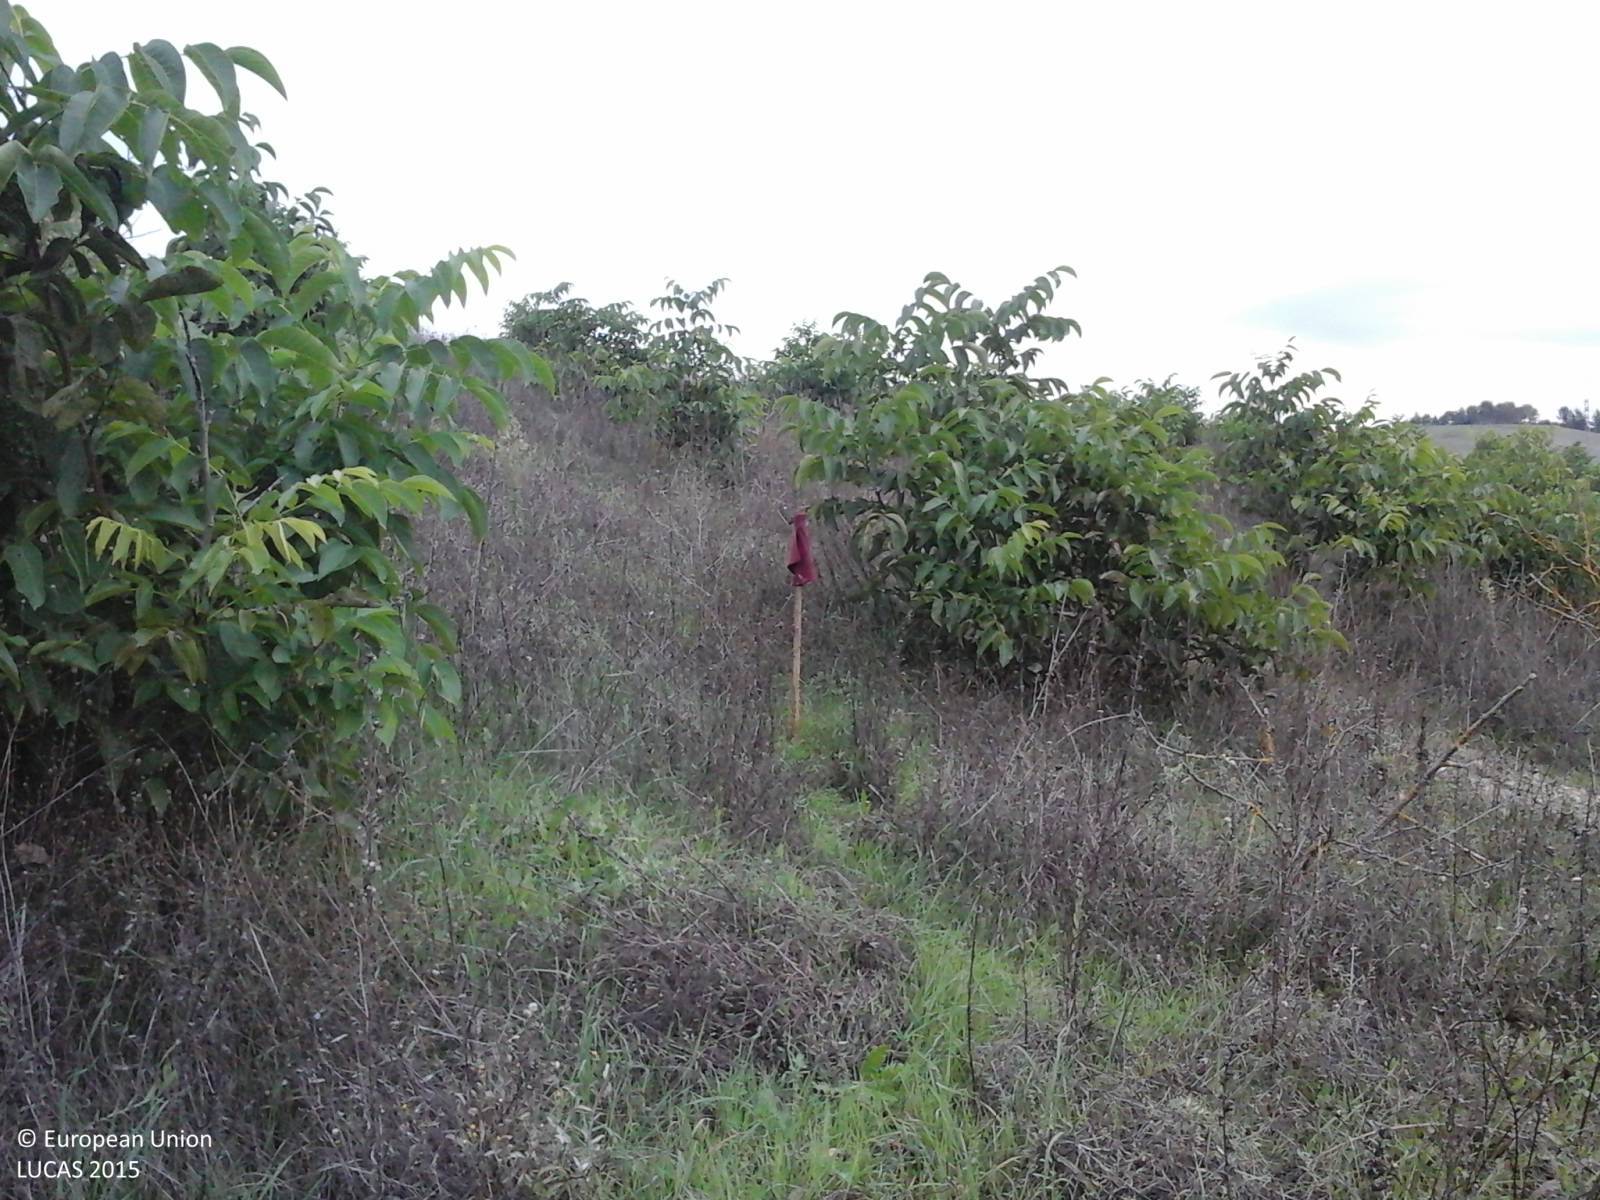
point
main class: Cropland
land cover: Nuts trees
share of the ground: 50 - 75 %
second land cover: Spontaneously vegetated surfaces
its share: > 75 %
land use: Agriculture (excluding fallow land and kitchen gardens)
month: October
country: IT
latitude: 42.6652
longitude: 12.2499
